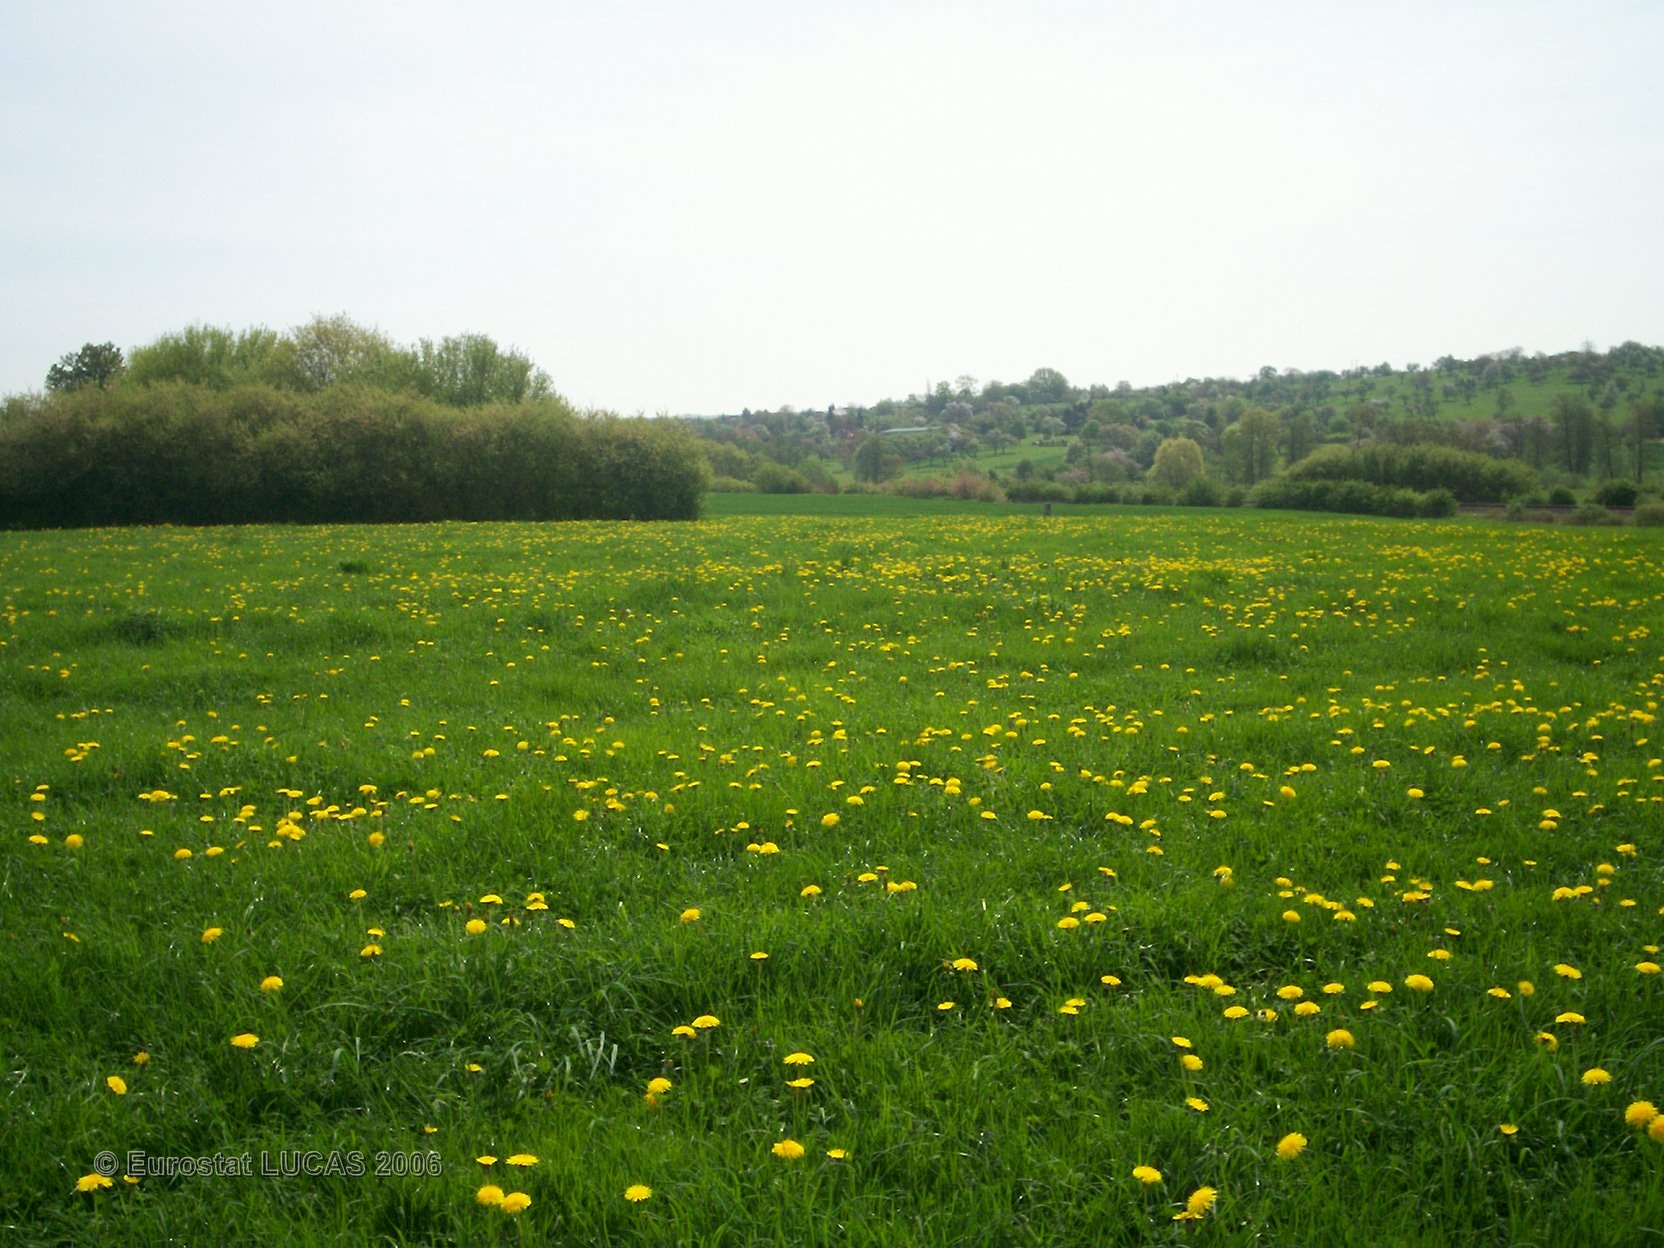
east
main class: Grassland
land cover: Grassland without tree/shrub cover
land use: Agriculture (excluding fallow land and kitchen gardens)
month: May
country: FR
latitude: 48.9407
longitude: 7.0652
